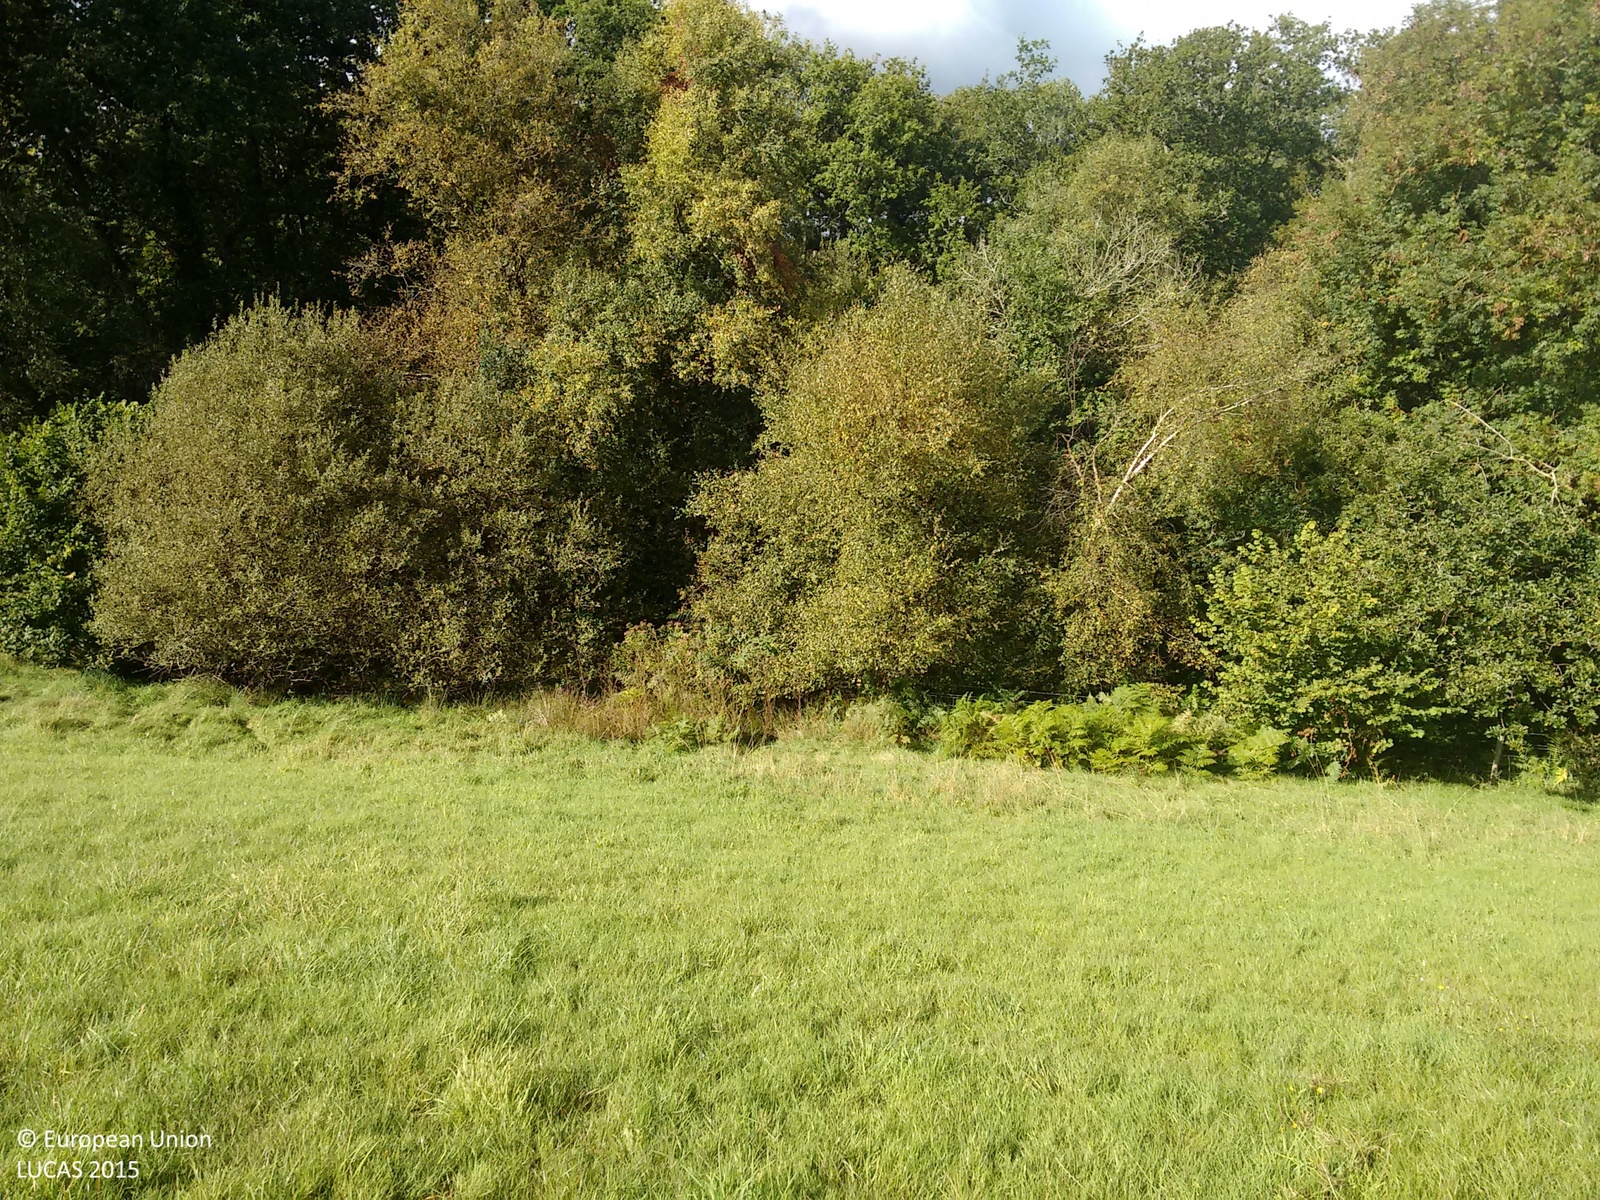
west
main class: Grassland
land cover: Grassland without tree/shrub cover
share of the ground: > 75 %
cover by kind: herbaceous plants 100 %
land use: Agriculture (excluding fallow land and kitchen gardens)
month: September
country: GB
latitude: 50.7390
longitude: -3.8501
